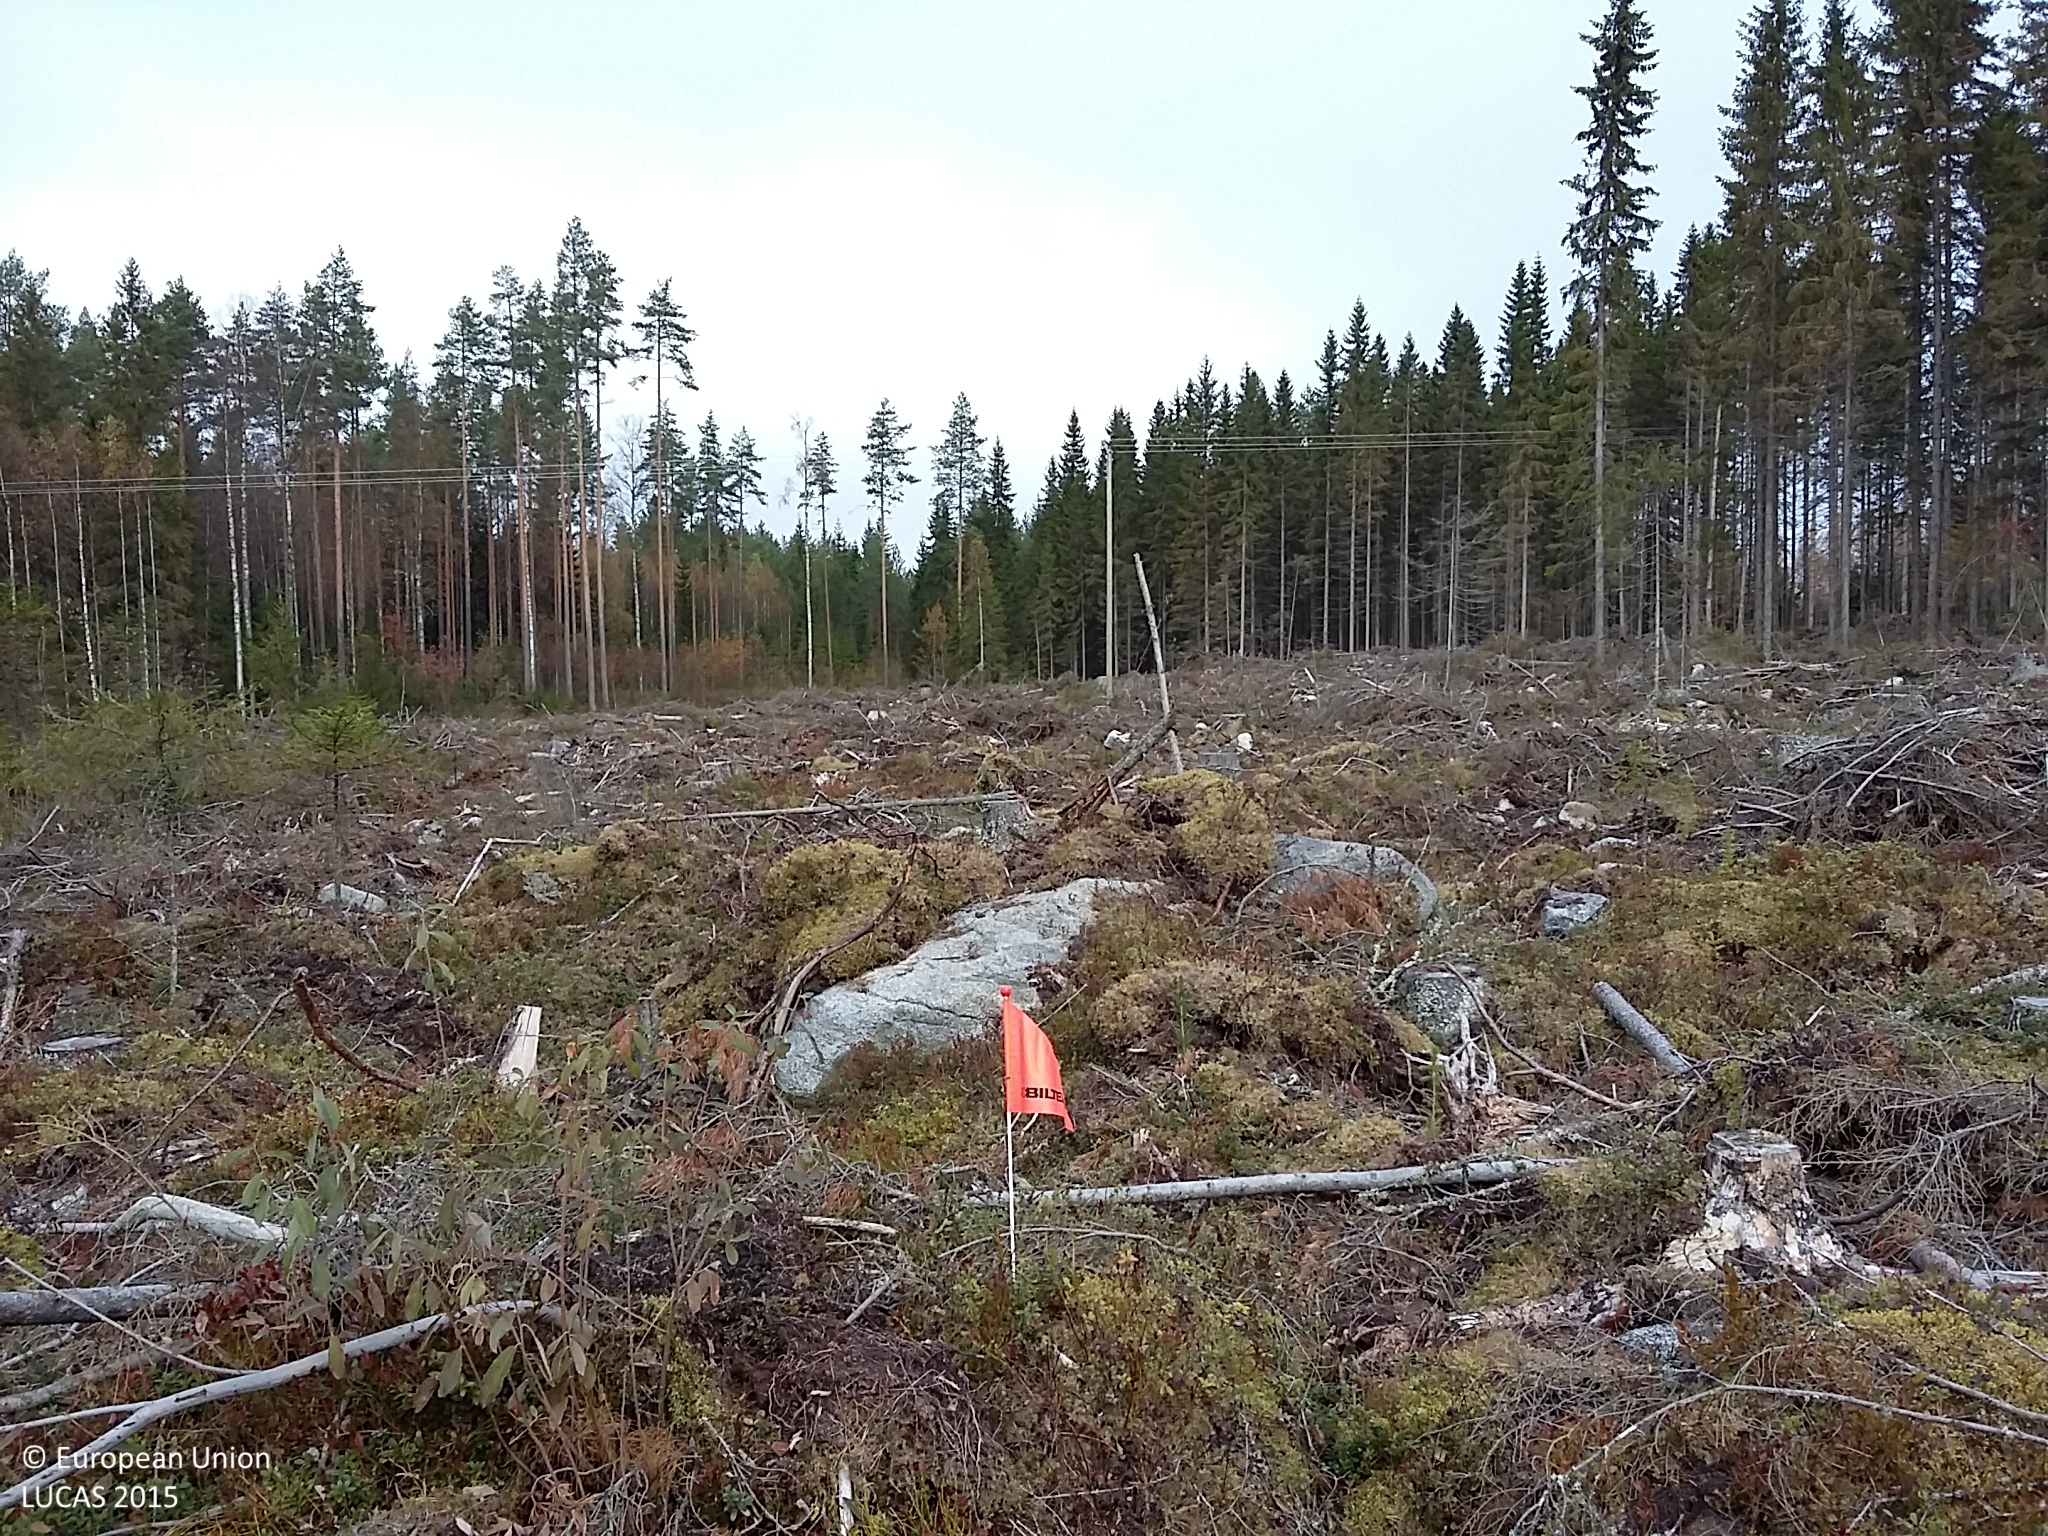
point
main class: Shrubland
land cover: Shrubland with sparse tree cover
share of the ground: 10 - 25 %
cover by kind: lichens and mosses 35 %, unconsolidated bare surface 25 %, shrubs 15 %, coniferous forest trees 5 %, herbaceous plants 5 %, consolidated bare surface 5 %
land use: Forestry
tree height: < 5 m
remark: Clear cut
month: October
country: FI
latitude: 62.5132
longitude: 26.2701
